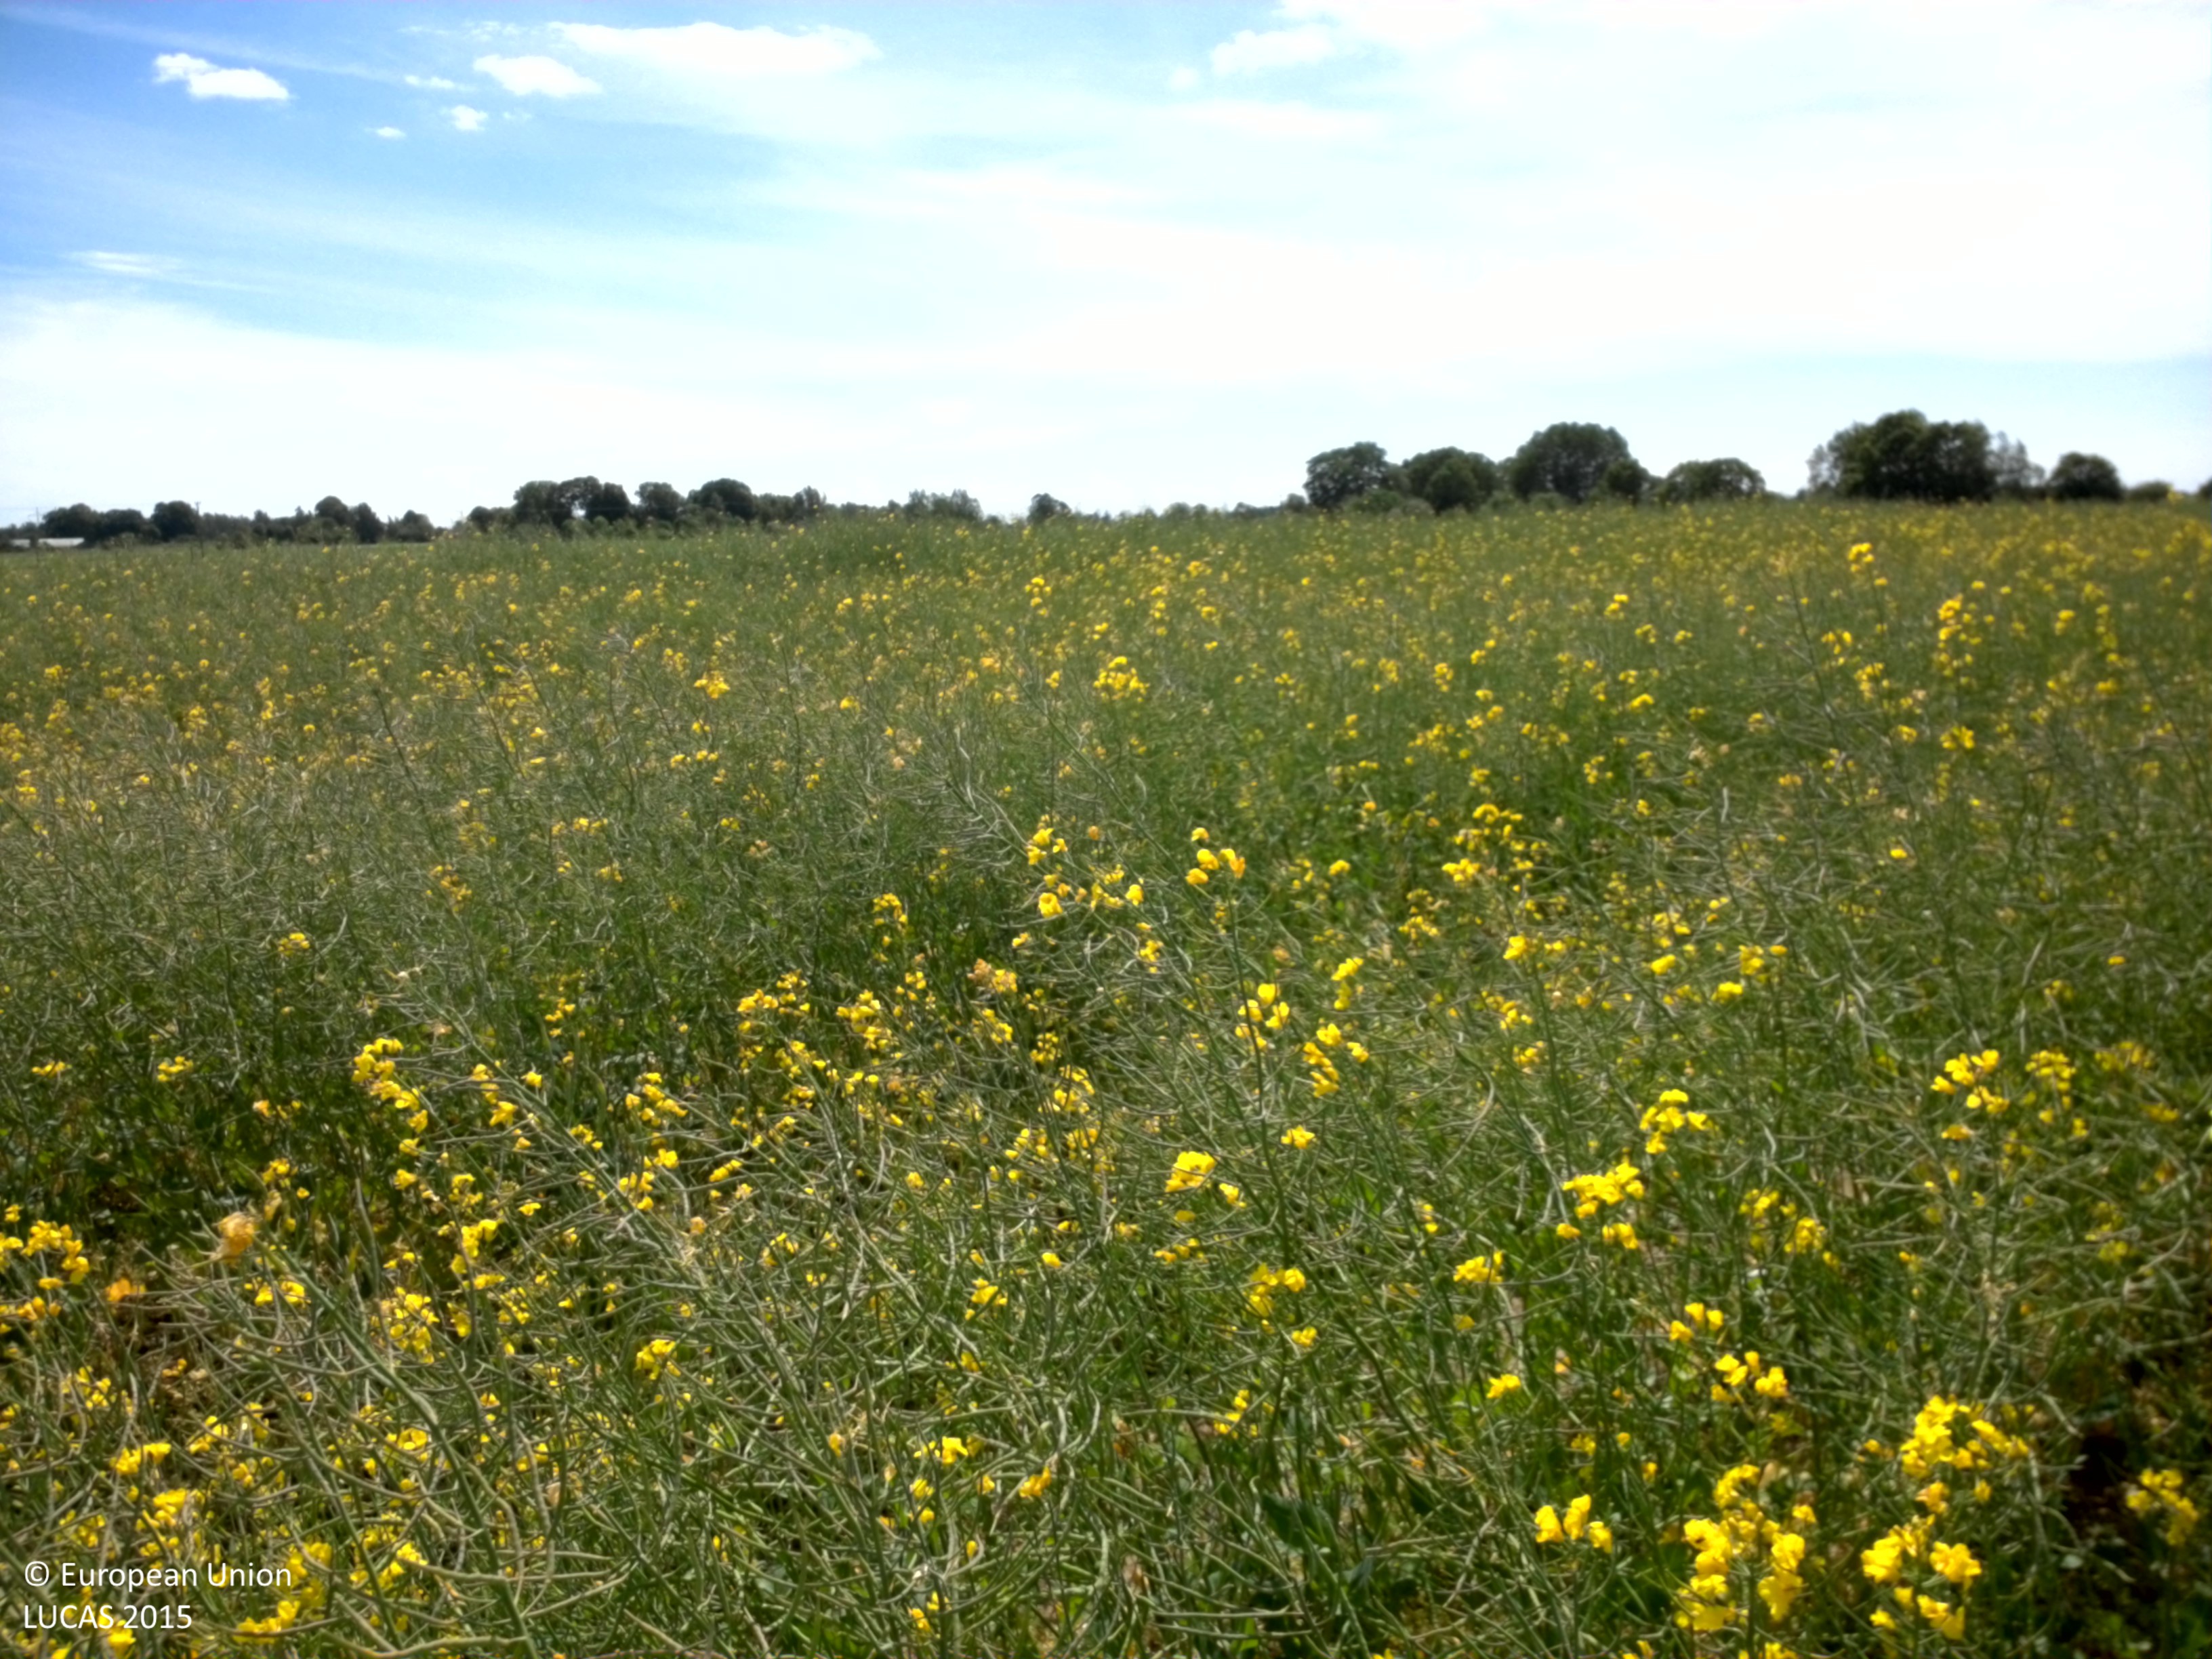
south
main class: Cropland
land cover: Rape and turnip rape
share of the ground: > 75 %
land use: Agriculture (excluding fallow land and kitchen gardens)
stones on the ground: < 10 %
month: June
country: SE
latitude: 58.5064
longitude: 15.4345
